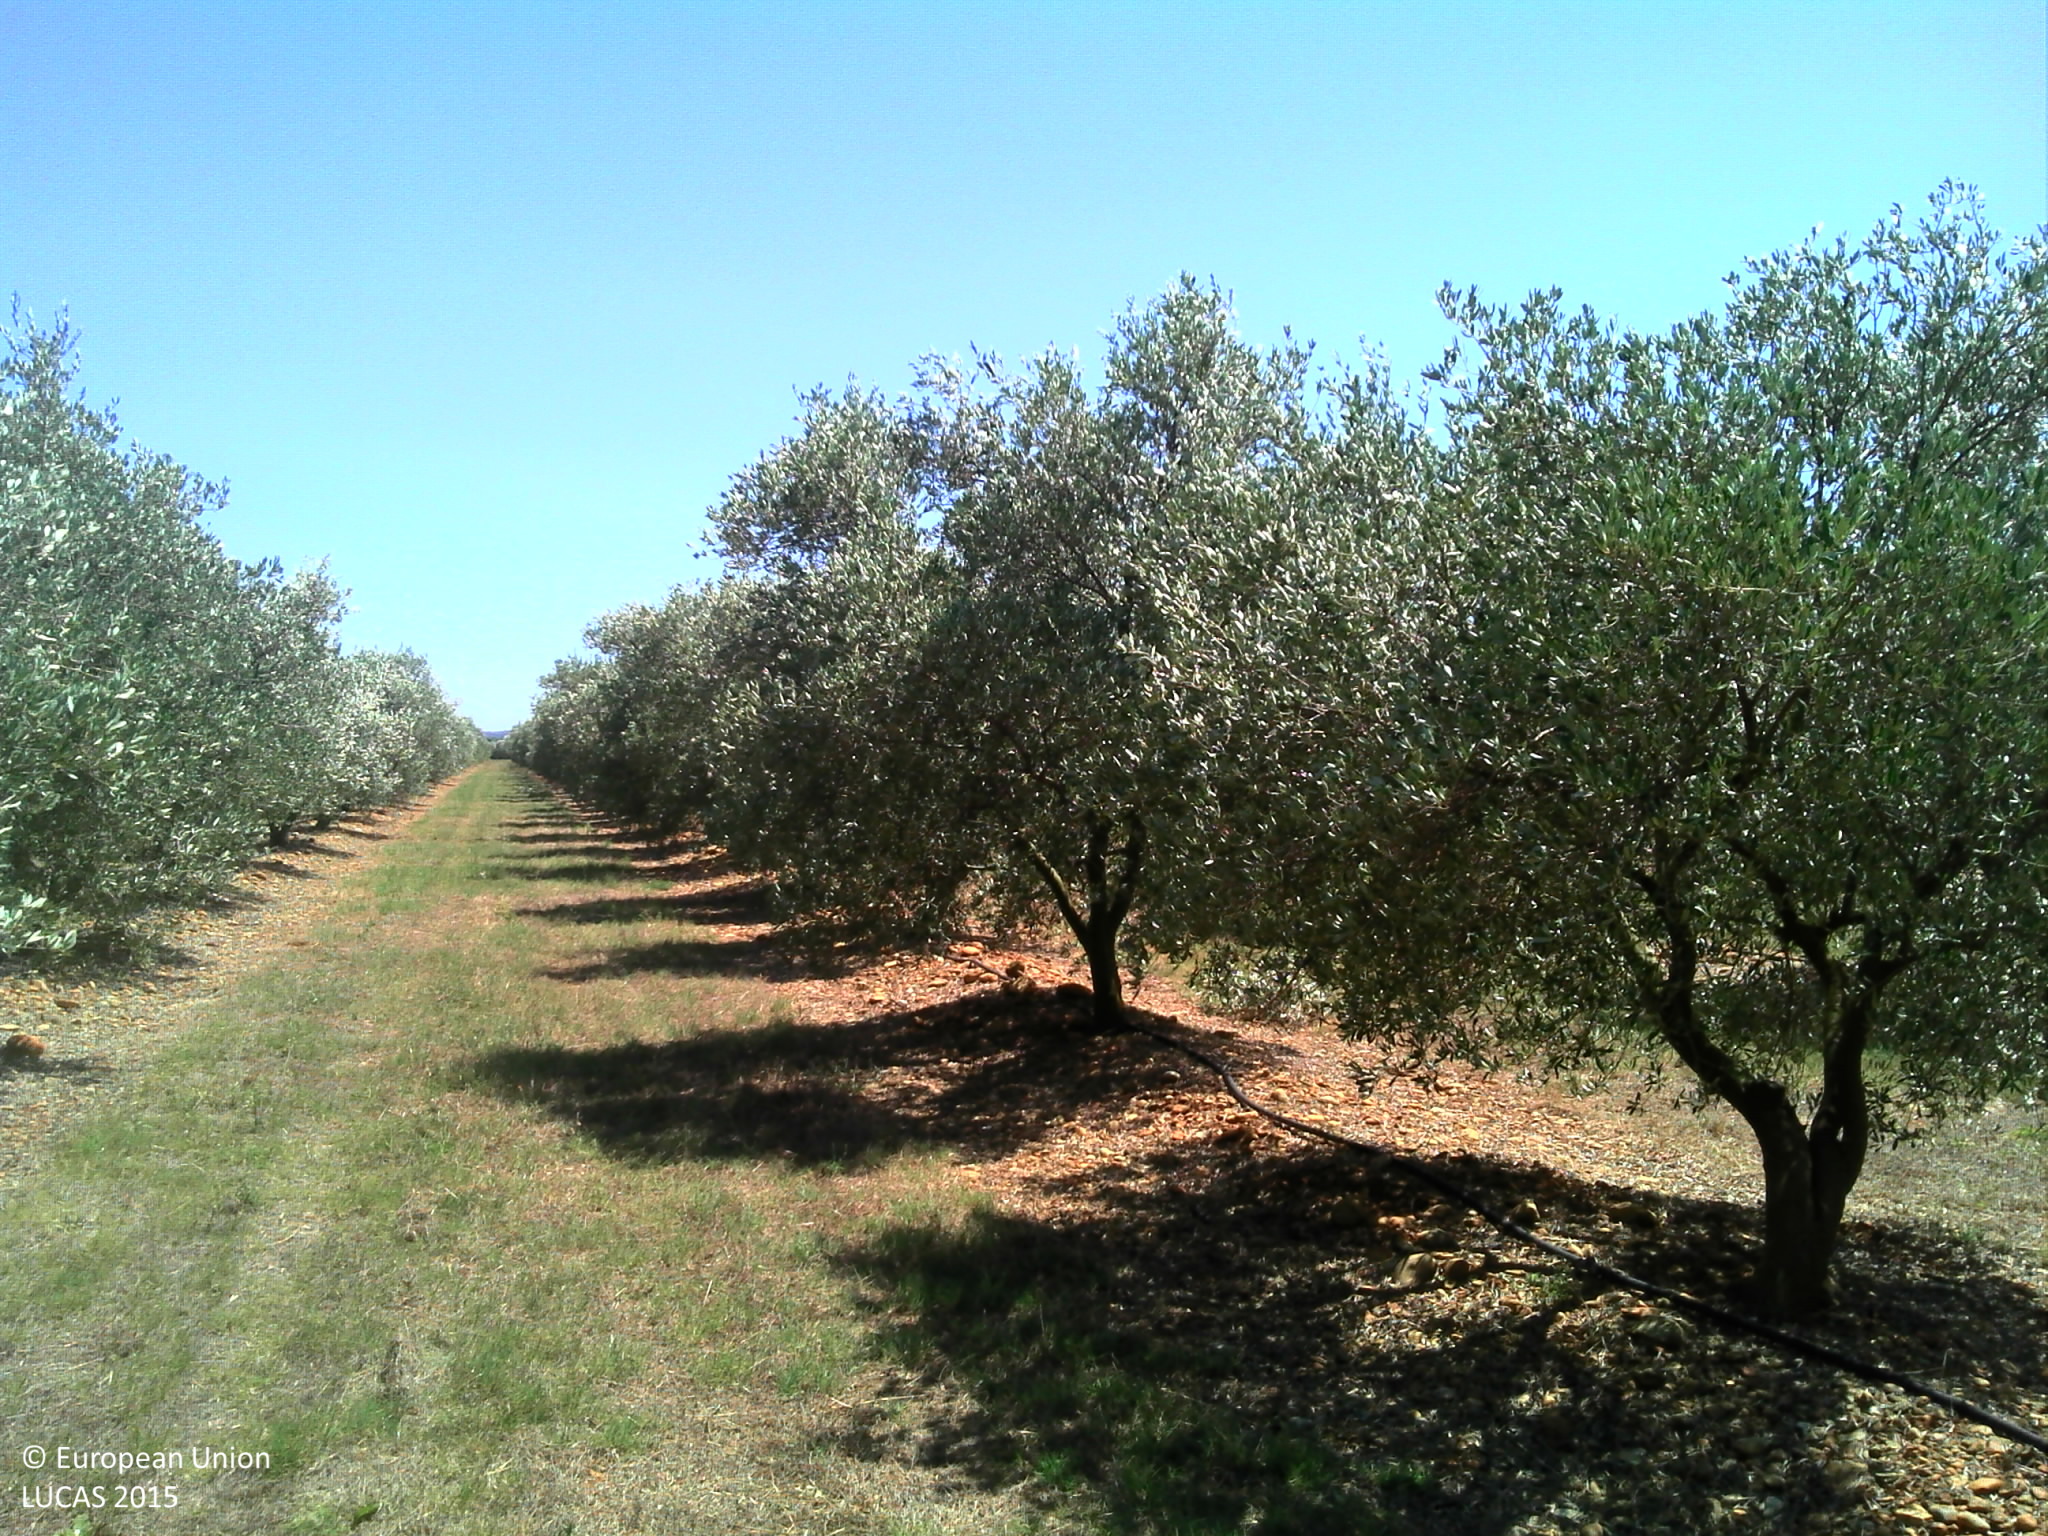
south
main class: Cropland
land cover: Olive groves
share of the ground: 25 - 50 %
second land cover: Grassland without tree/shrub cover
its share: > 75 %
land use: Agriculture (excluding fallow land and kitchen gardens)
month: July
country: FR
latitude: 43.6761
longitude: 4.7627
